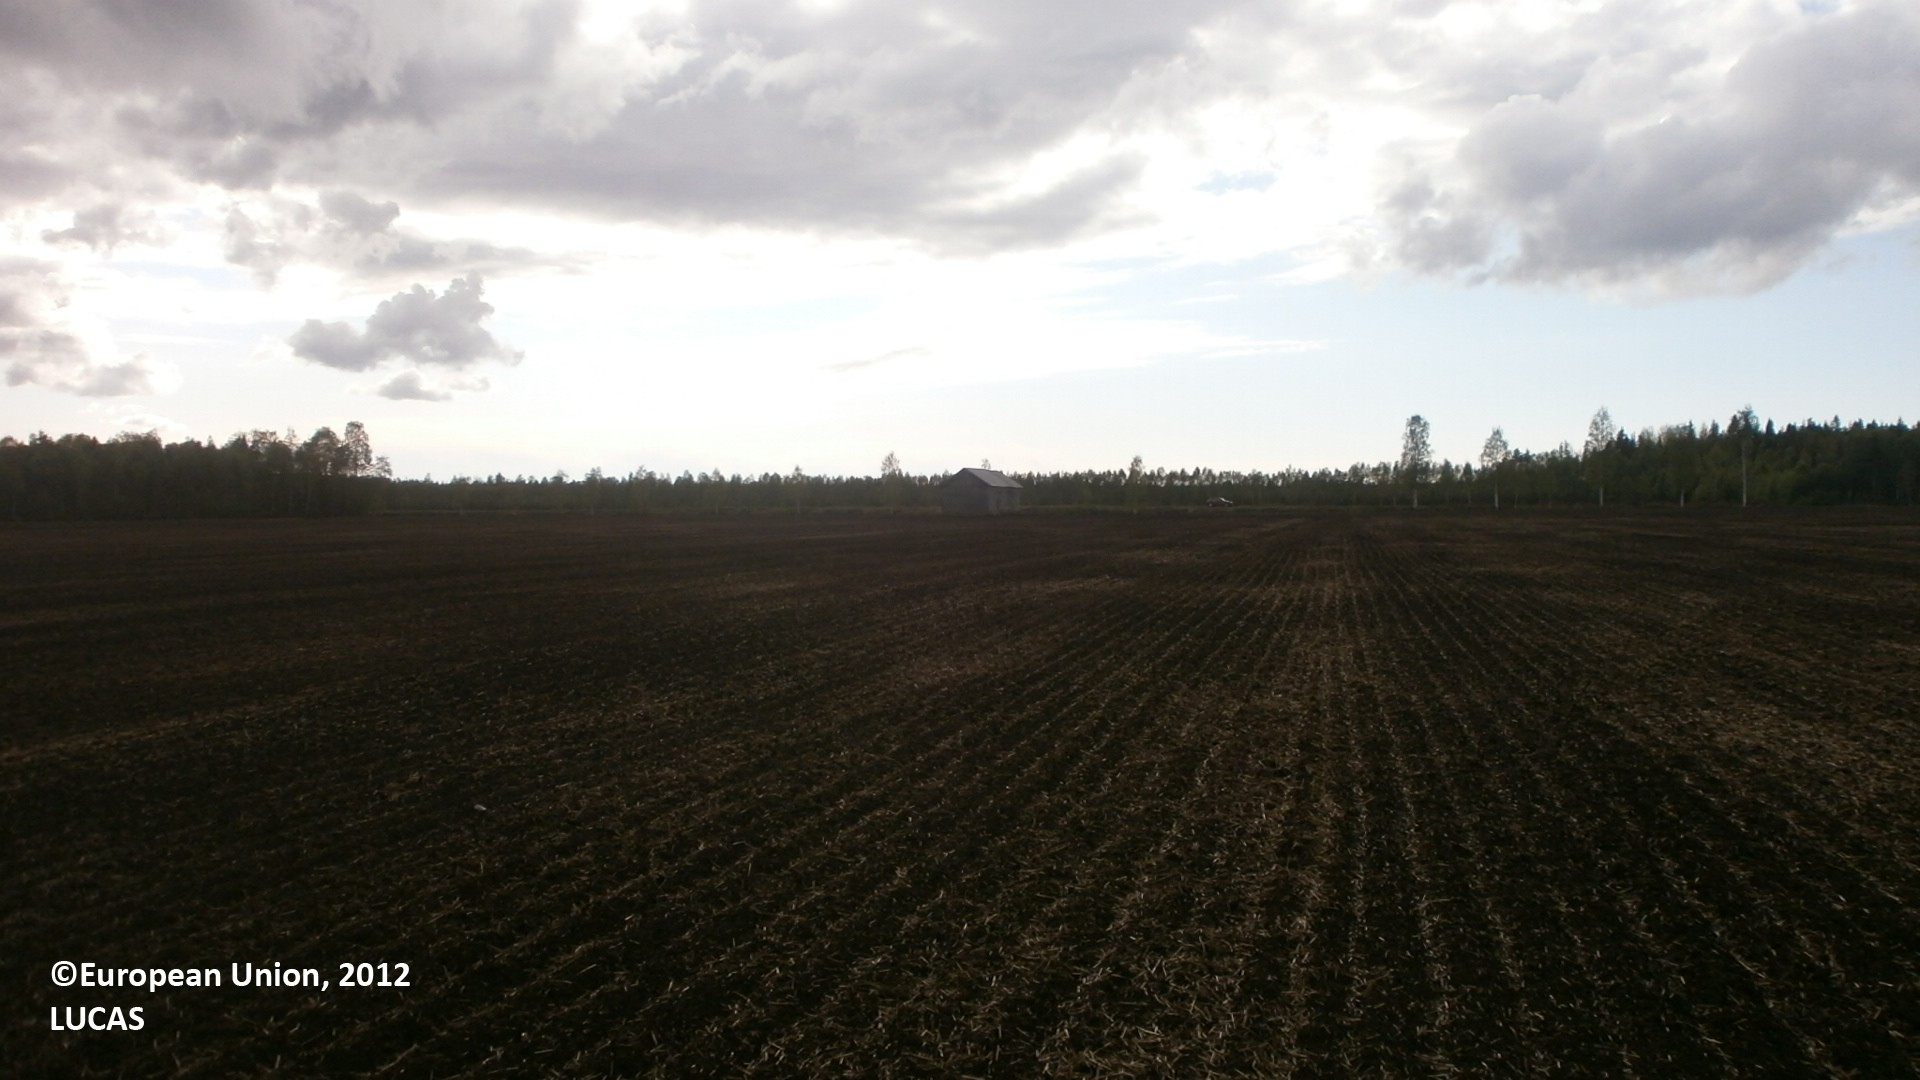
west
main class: Cropland
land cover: Barley
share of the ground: < 10 %
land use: Agriculture (excluding fallow land and kitchen gardens)
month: June
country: FI
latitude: 64.6808
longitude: 25.1481
